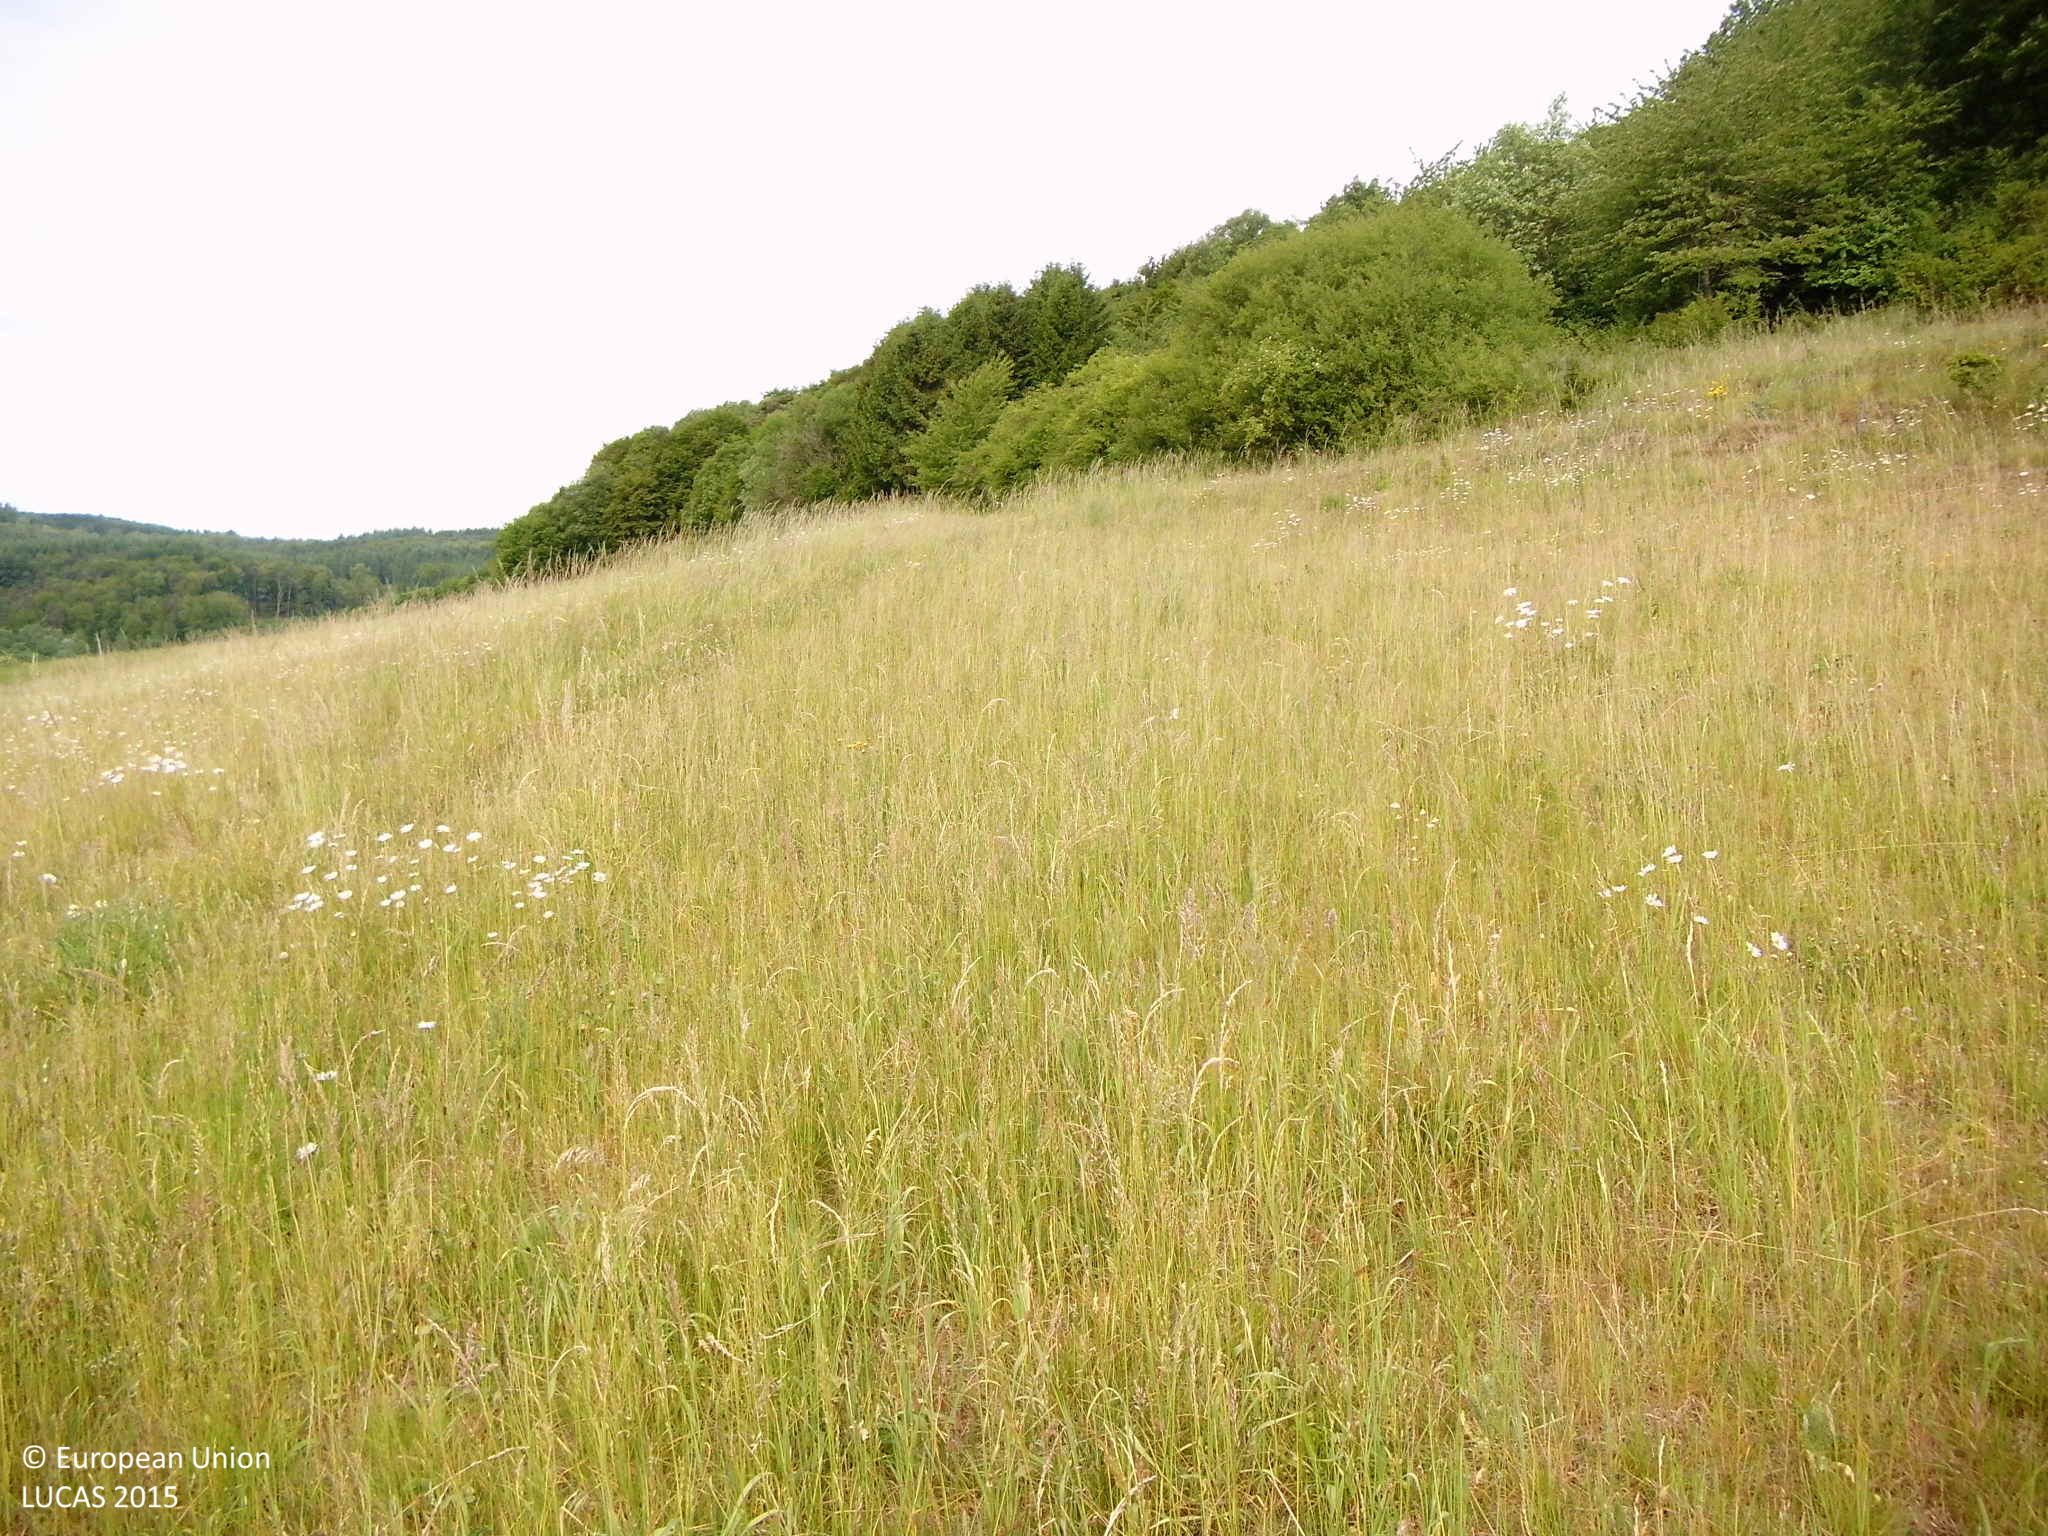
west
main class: Grassland
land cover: Grassland without tree/shrub cover
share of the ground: > 75 %
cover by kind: herbaceous plants 100 %
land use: Agriculture (excluding fallow land and kitchen gardens)
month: June
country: DE
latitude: 50.7672
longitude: 8.4549
